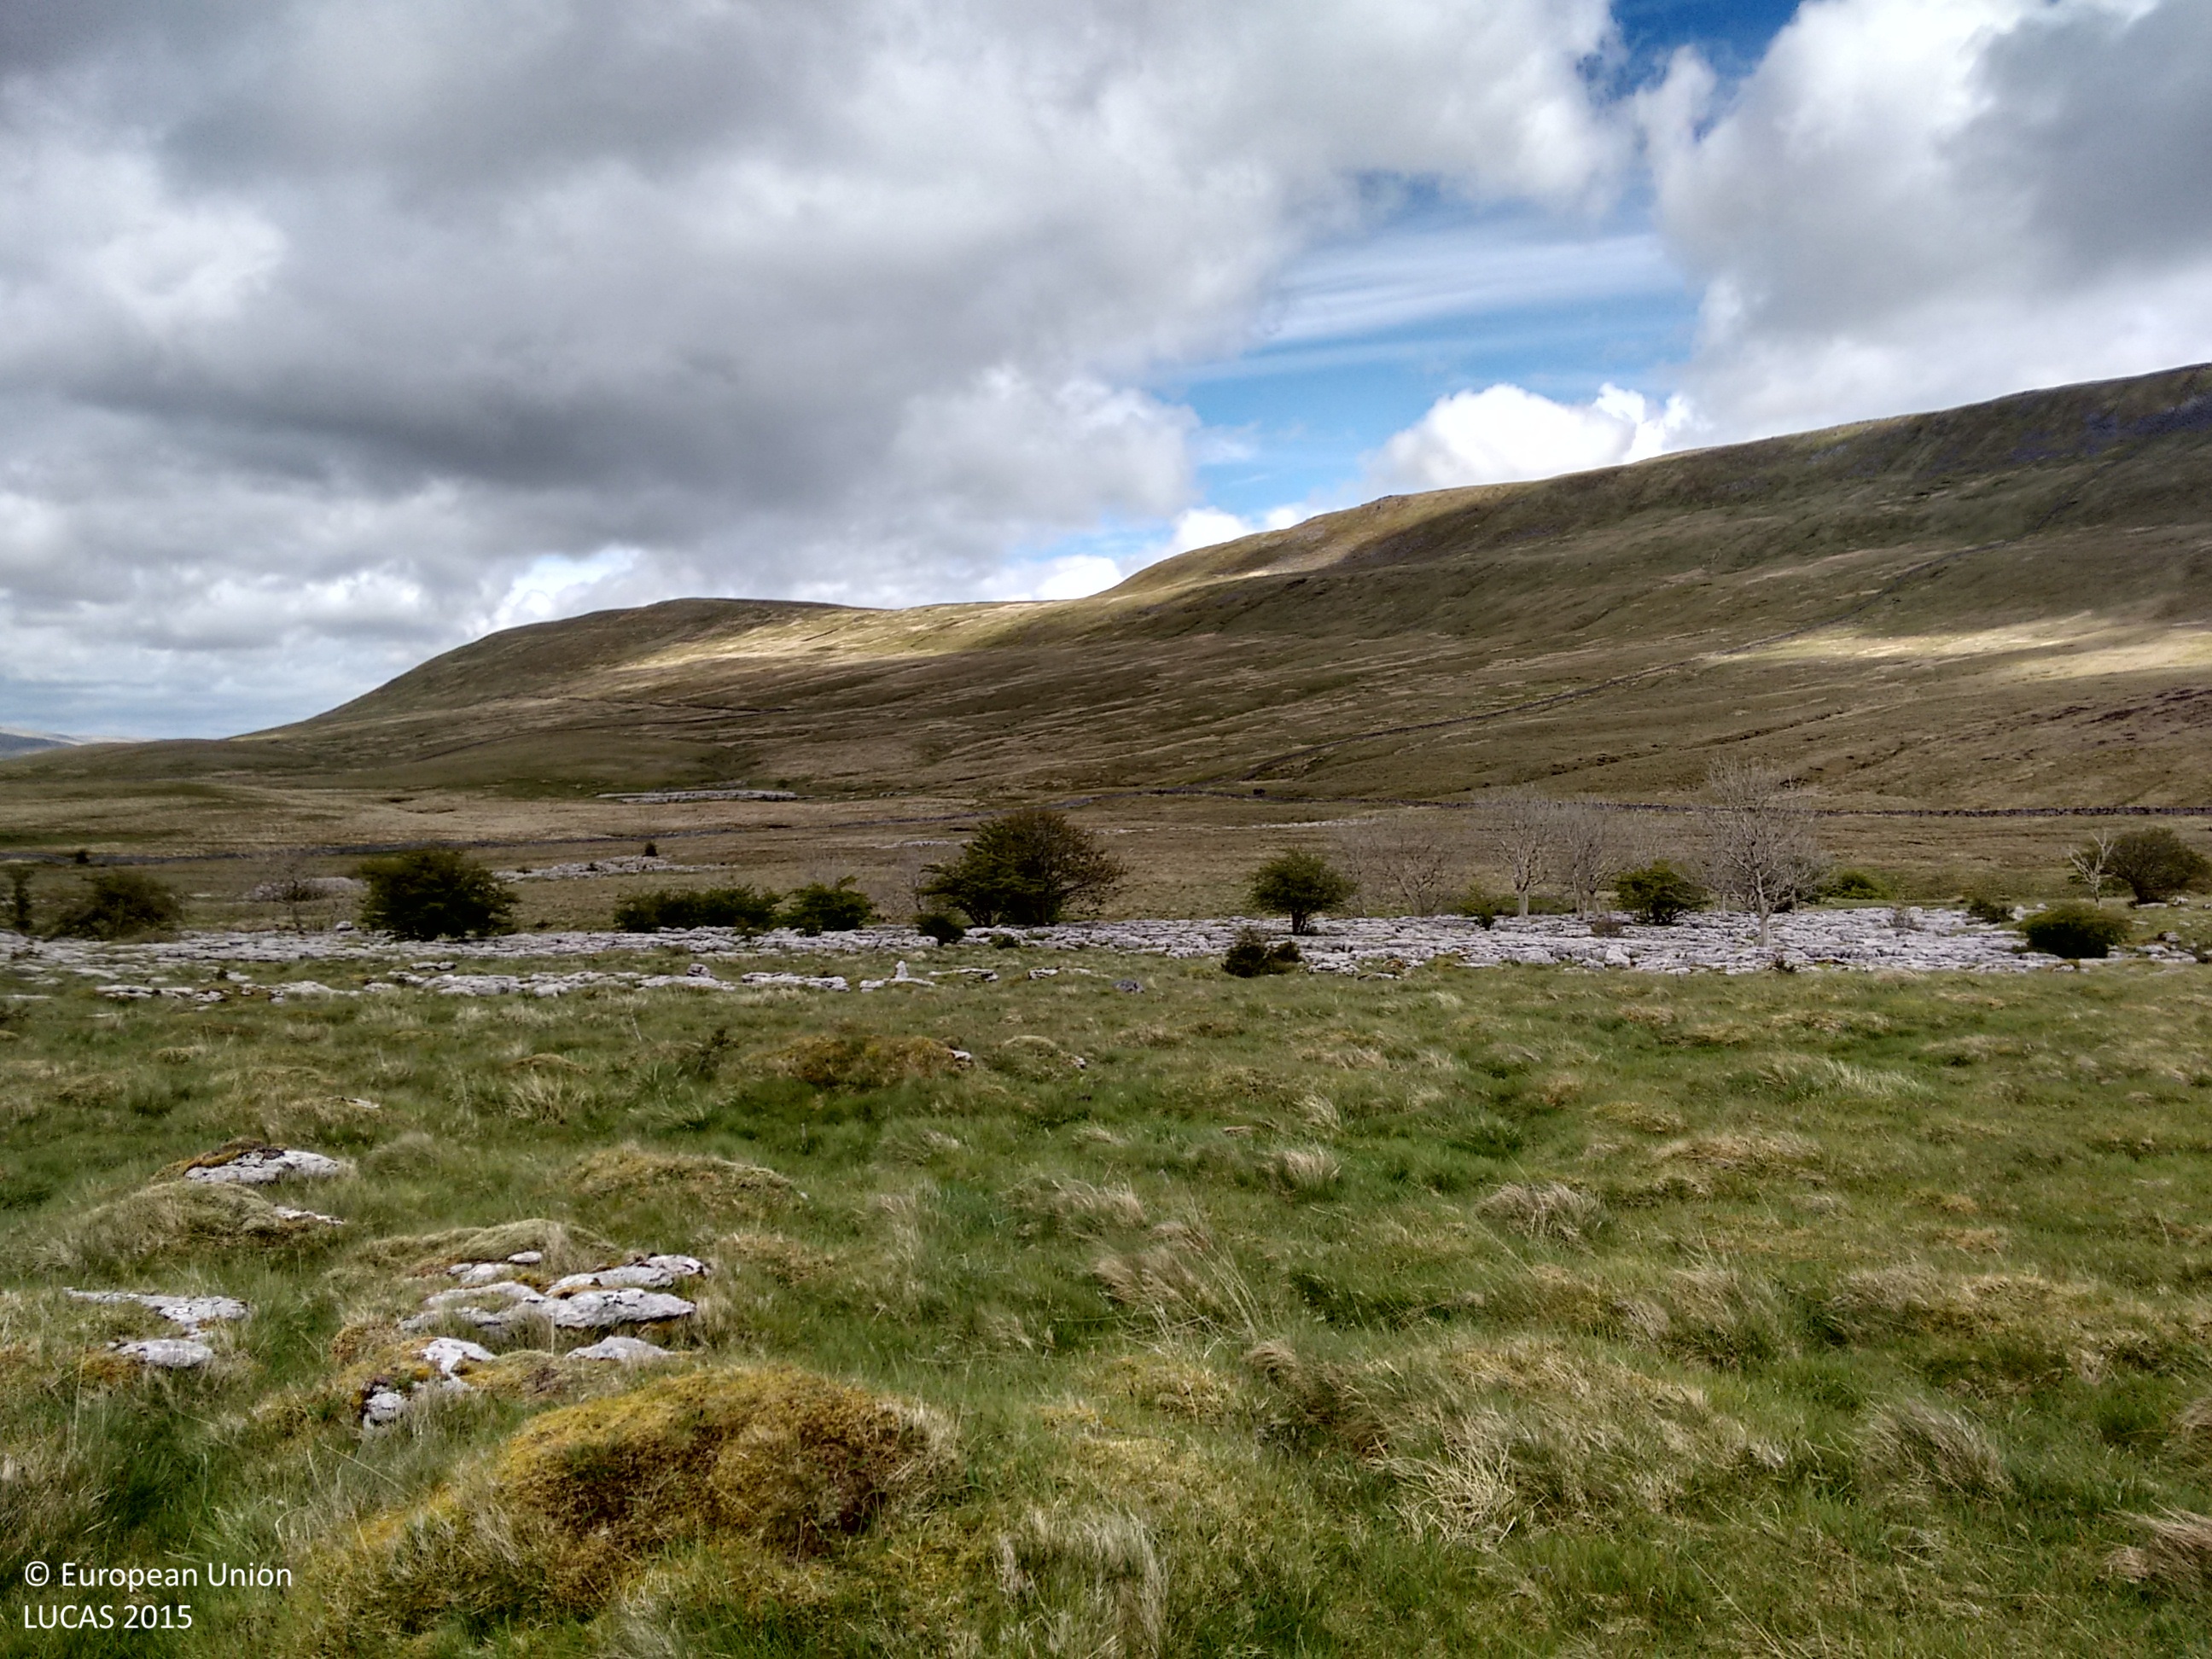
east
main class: Grassland
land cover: Grassland without tree/shrub cover
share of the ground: > 75 %
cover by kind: herbaceous plants 100 %
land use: Agriculture (excluding fallow land and kitchen gardens)
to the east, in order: Grassland without tree/shrub cover; Rock outcrops; Grassland without tree/shrub cover
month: June
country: GB
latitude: 54.1816
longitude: -2.3973
